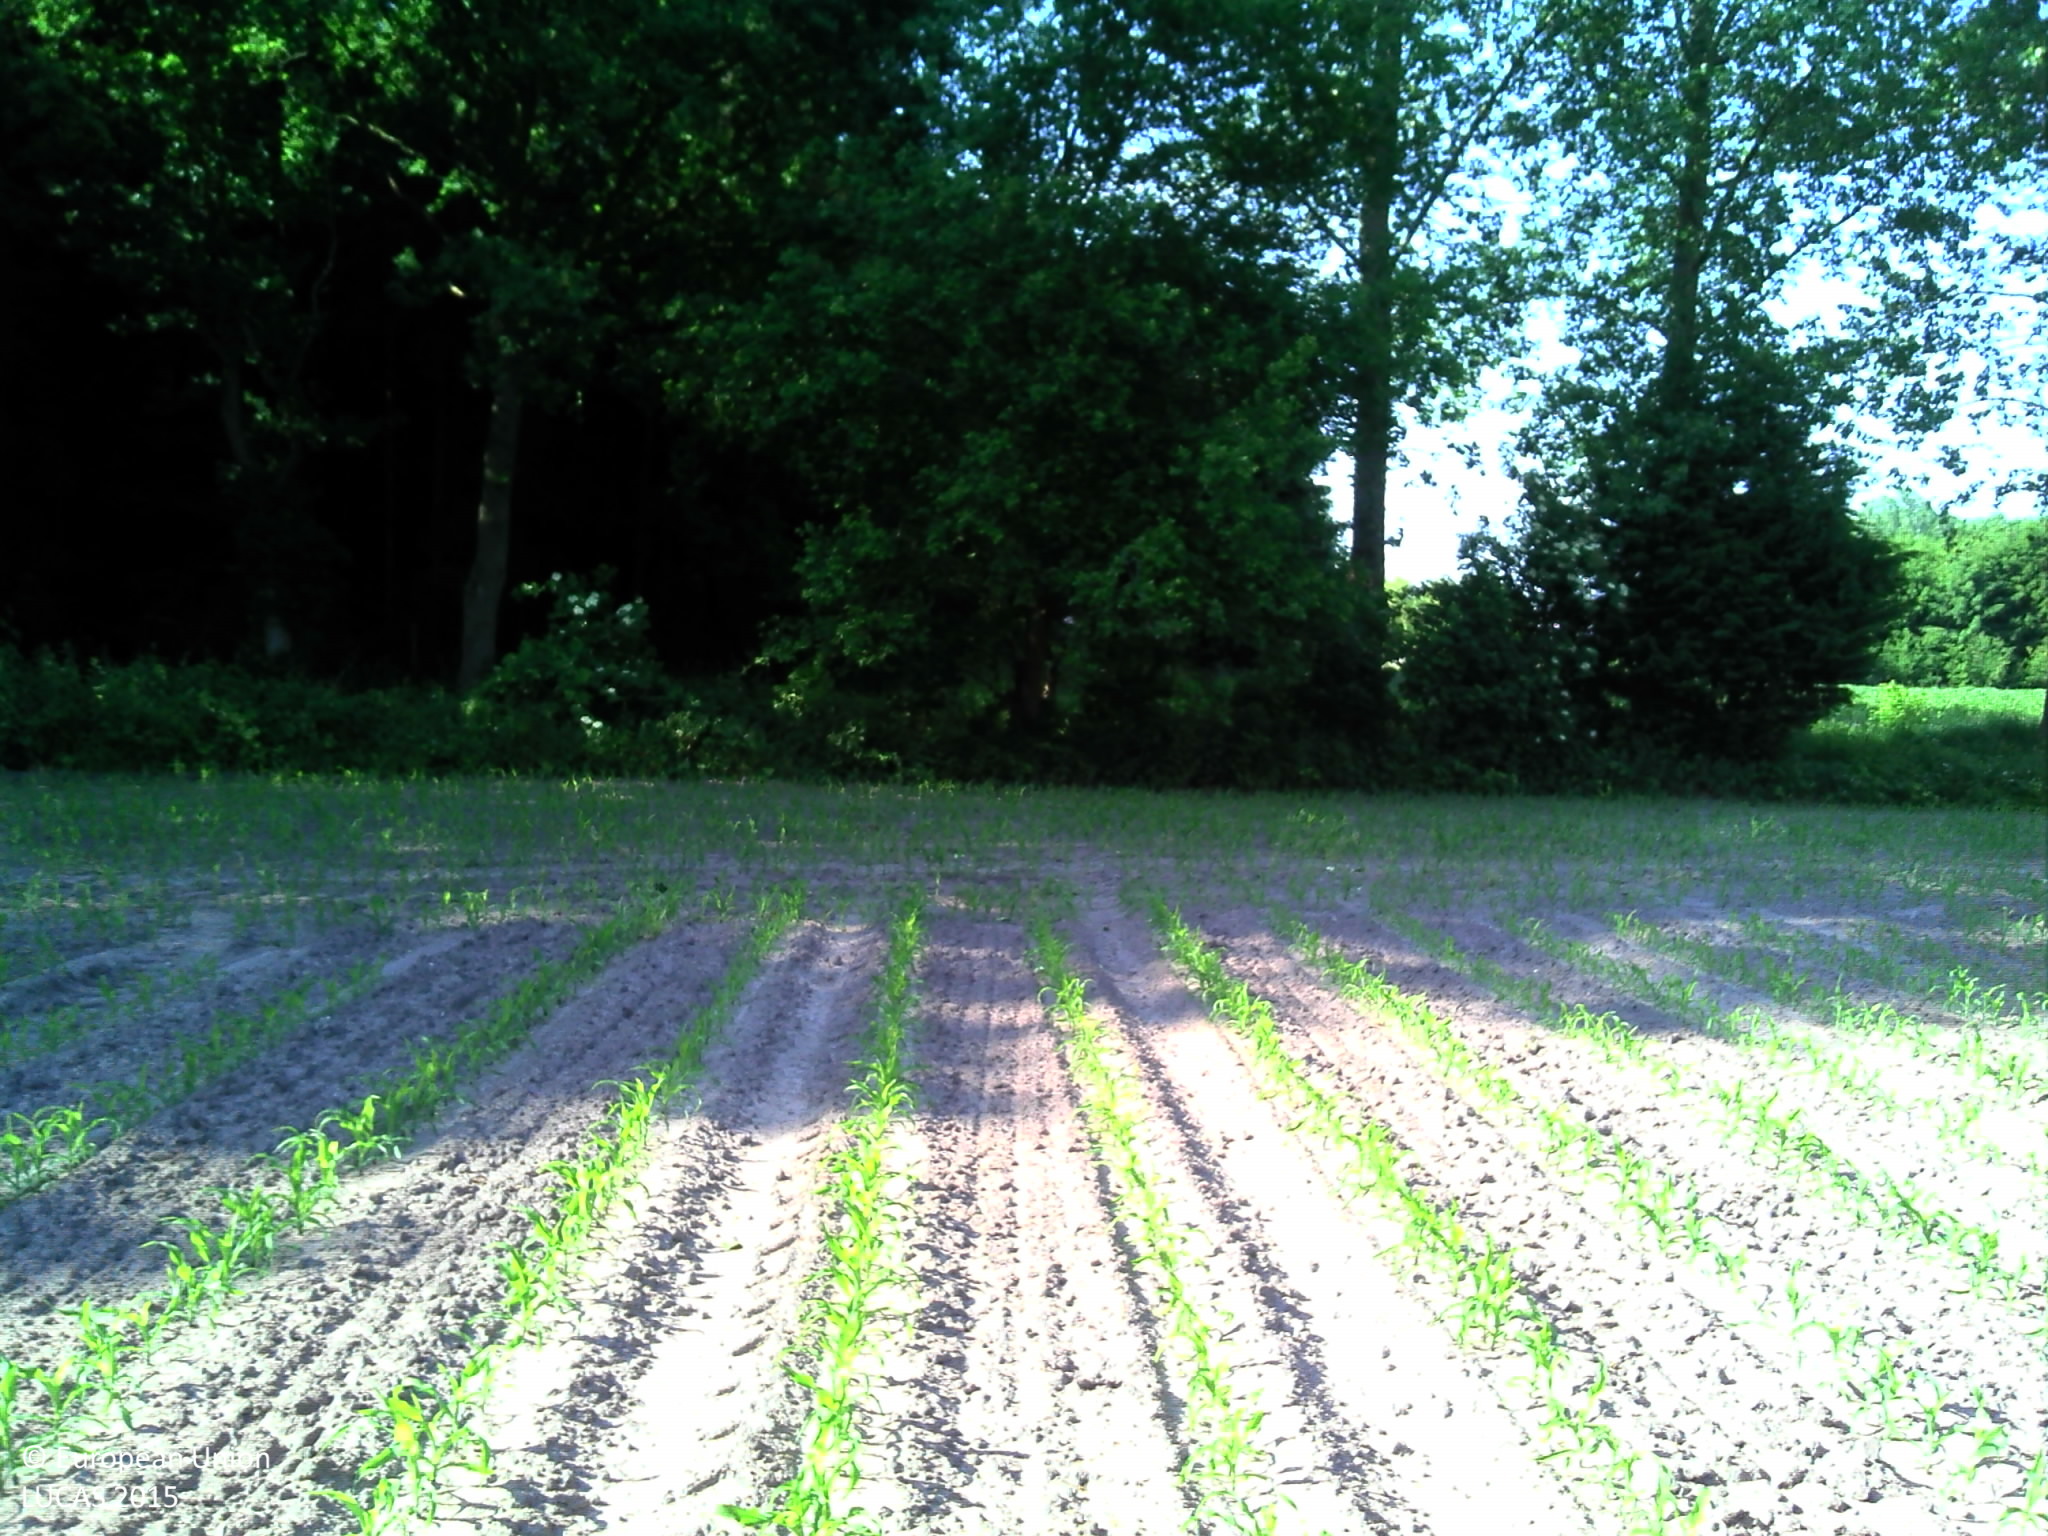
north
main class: Cropland
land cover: Maize
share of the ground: 10 - 25 %
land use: Agriculture (excluding fallow land and kitchen gardens)
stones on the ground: < 10 %
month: June
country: BE
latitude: 51.0086
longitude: 3.8222
